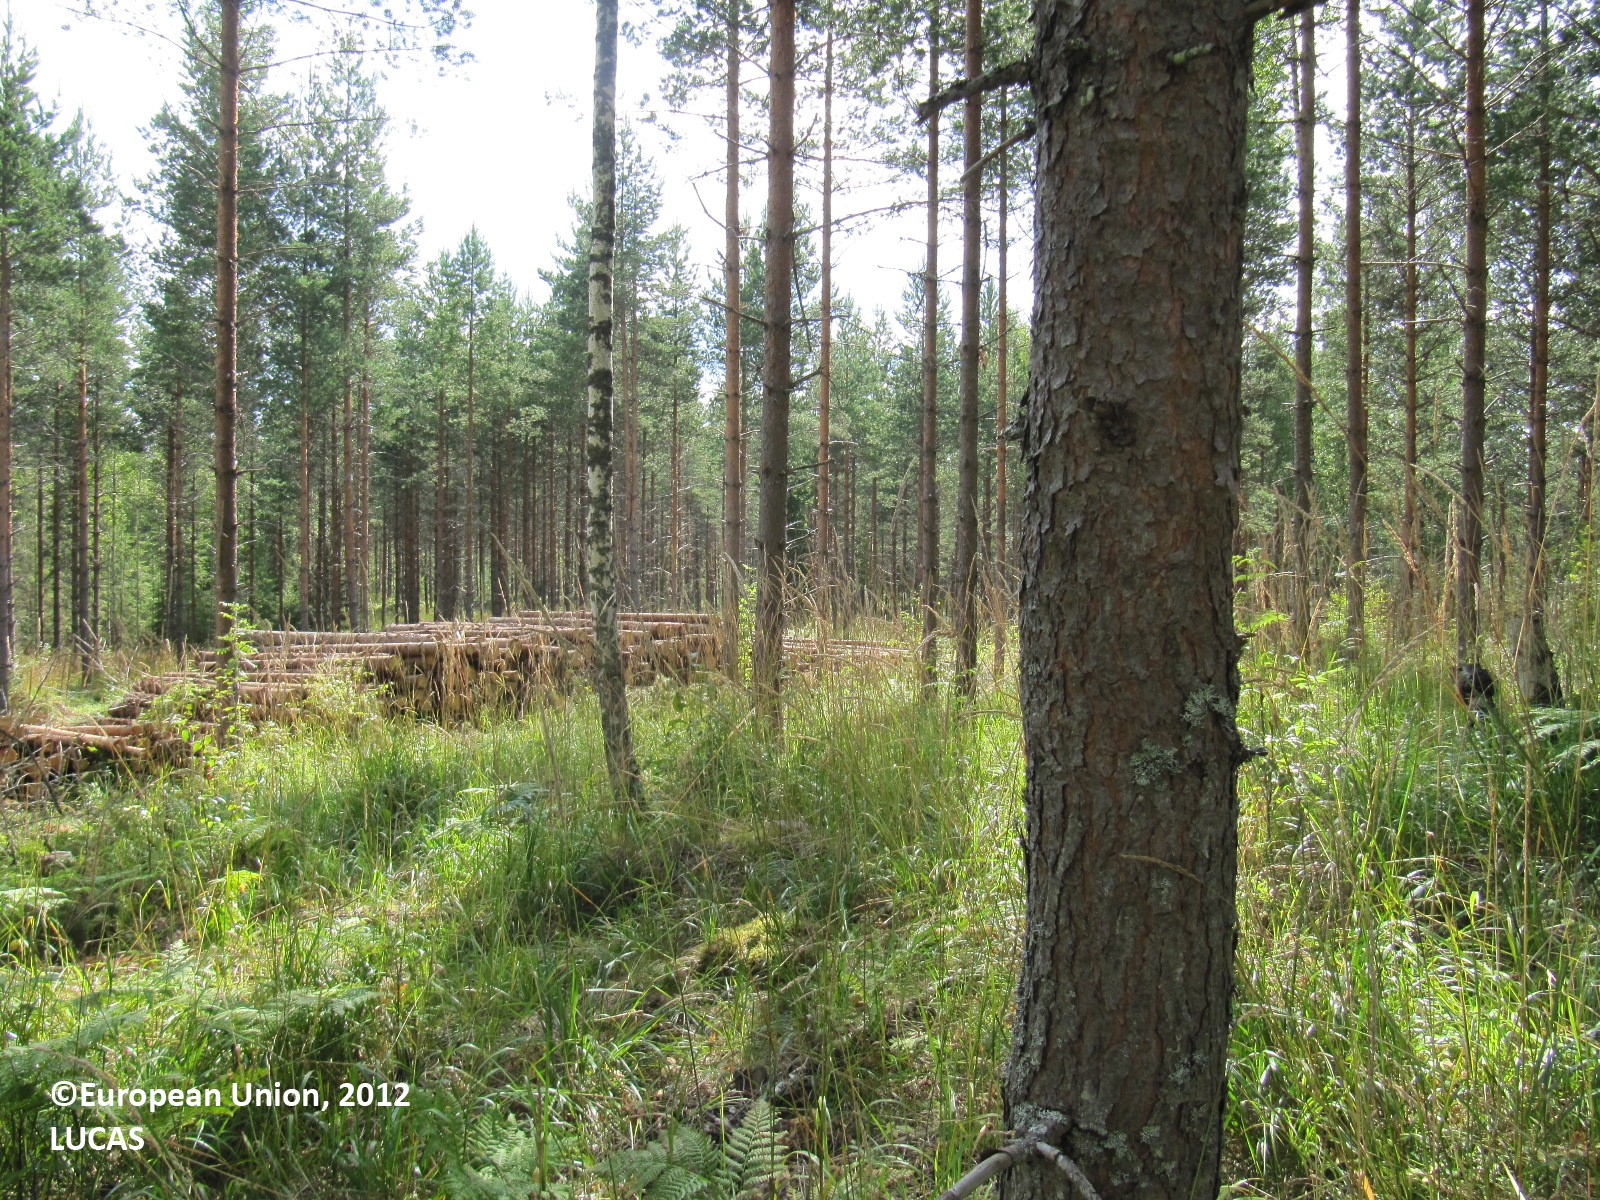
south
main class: Woodland
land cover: Pine dominated mixed woodland
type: boreal forest
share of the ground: 50 - 75 %
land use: Forestry
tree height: > 5 m
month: August
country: FI
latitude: 60.6911
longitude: 24.3309
